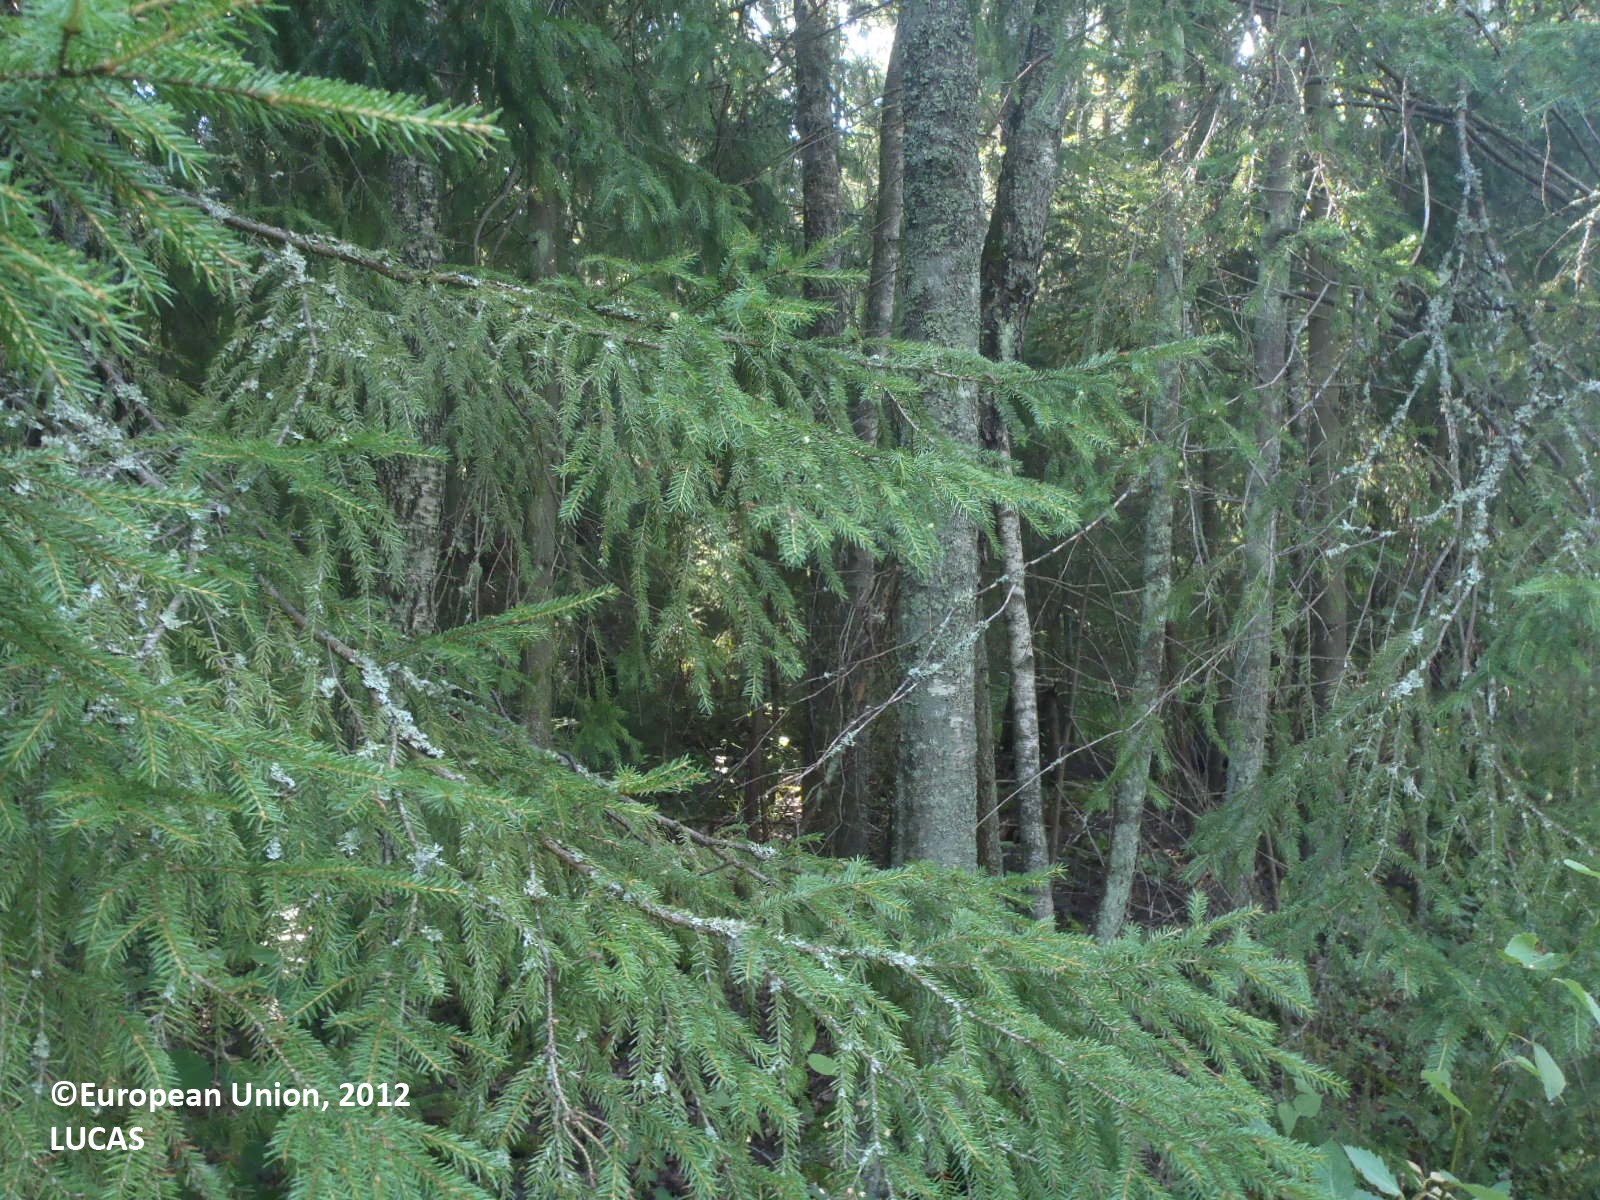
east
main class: Woodland
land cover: Spruce dominated mixed woodland
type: boreal forest
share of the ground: > 75 %
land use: Forestry
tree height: > 5 m
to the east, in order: Spruce dominated mixed woodland; Pine dominated coniferous woodland; Spruce dominated mixed woodland; Grassland without tree/shrub cover; Electric lines; Grass margins; Paved roads, cycling and walking lanes; Grassland without tree/shrub cover; Paved roads, cycling and walking lanes; Grass margins; Ditches and canals; Grassland without tree/shrub cover; Artificial constructions; Grassland without tree/shrub cover
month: July
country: FI
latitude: 60.3724
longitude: 22.2721
